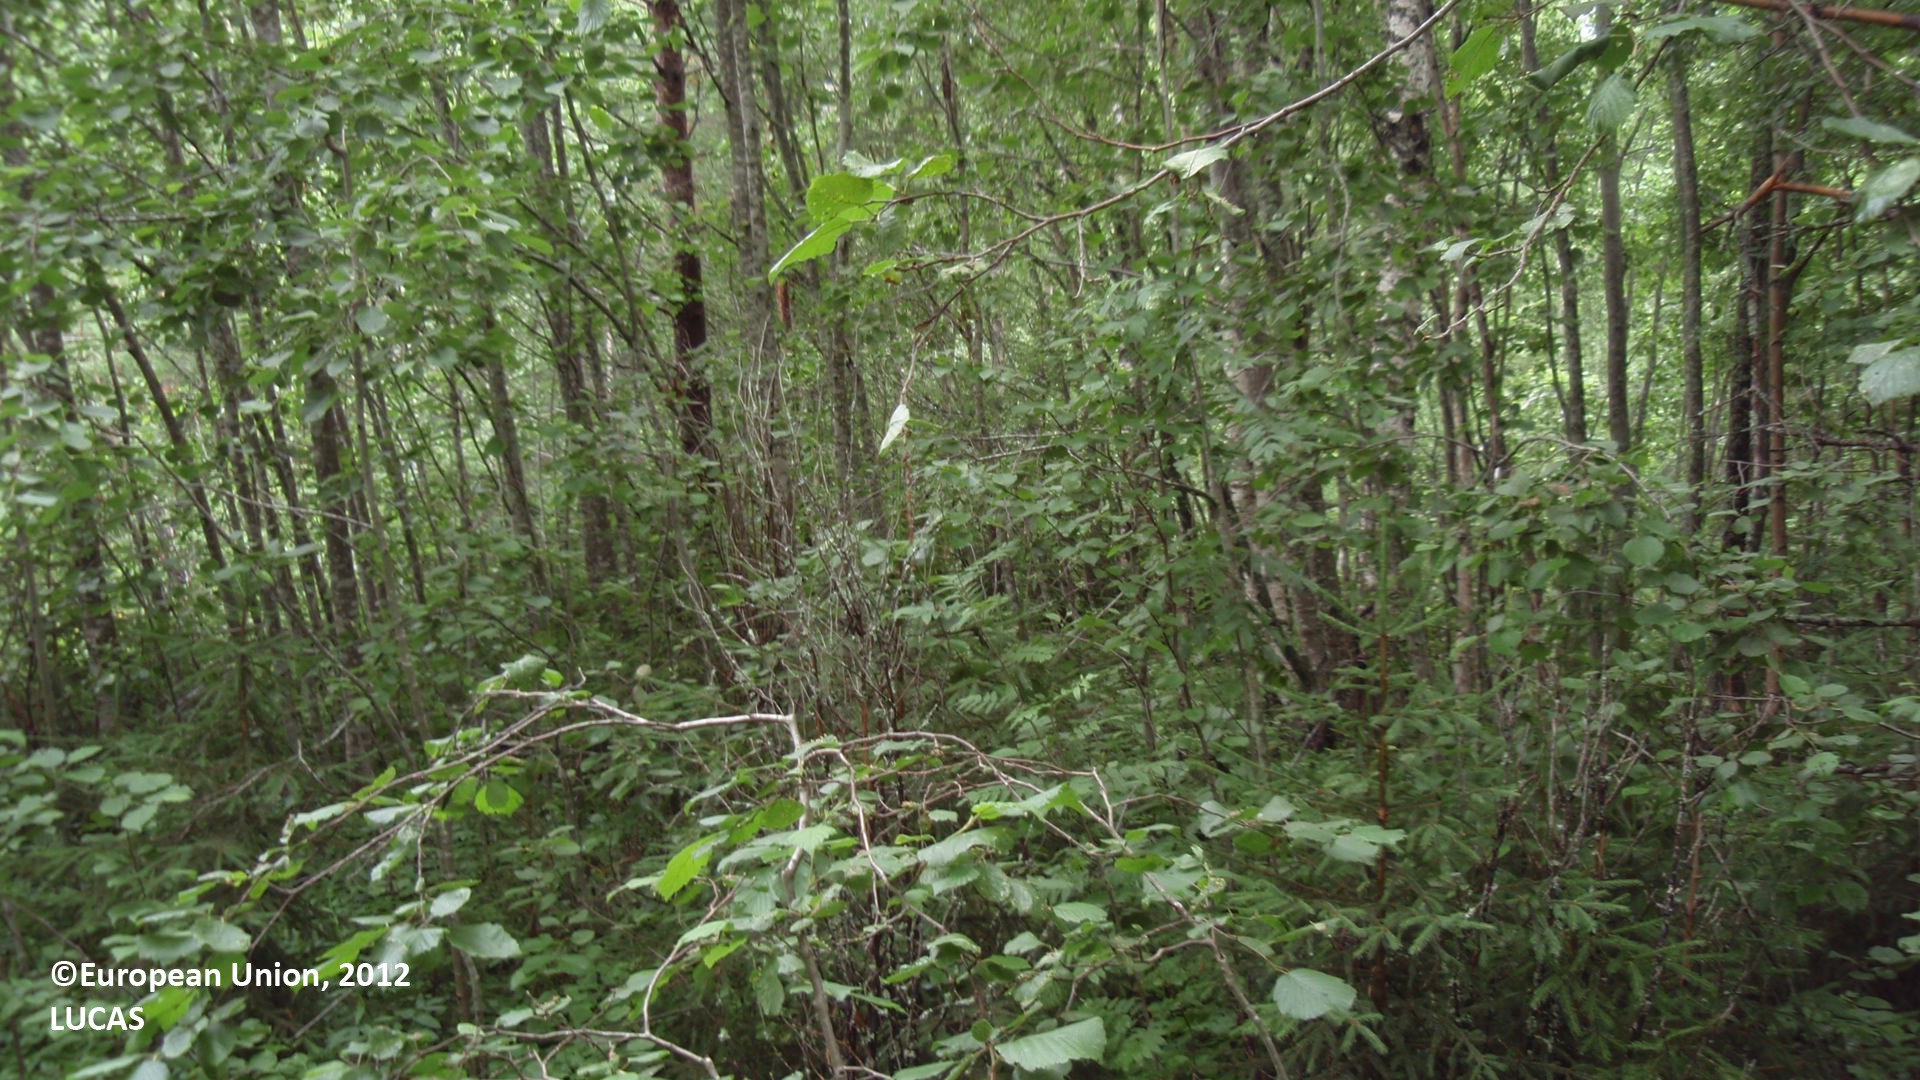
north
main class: Woodland
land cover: Pine dominated mixed woodland
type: boreal forest
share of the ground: > 75 %
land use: Forestry
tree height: > 5 m
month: July
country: FI
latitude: 61.4763
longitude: 26.9237
